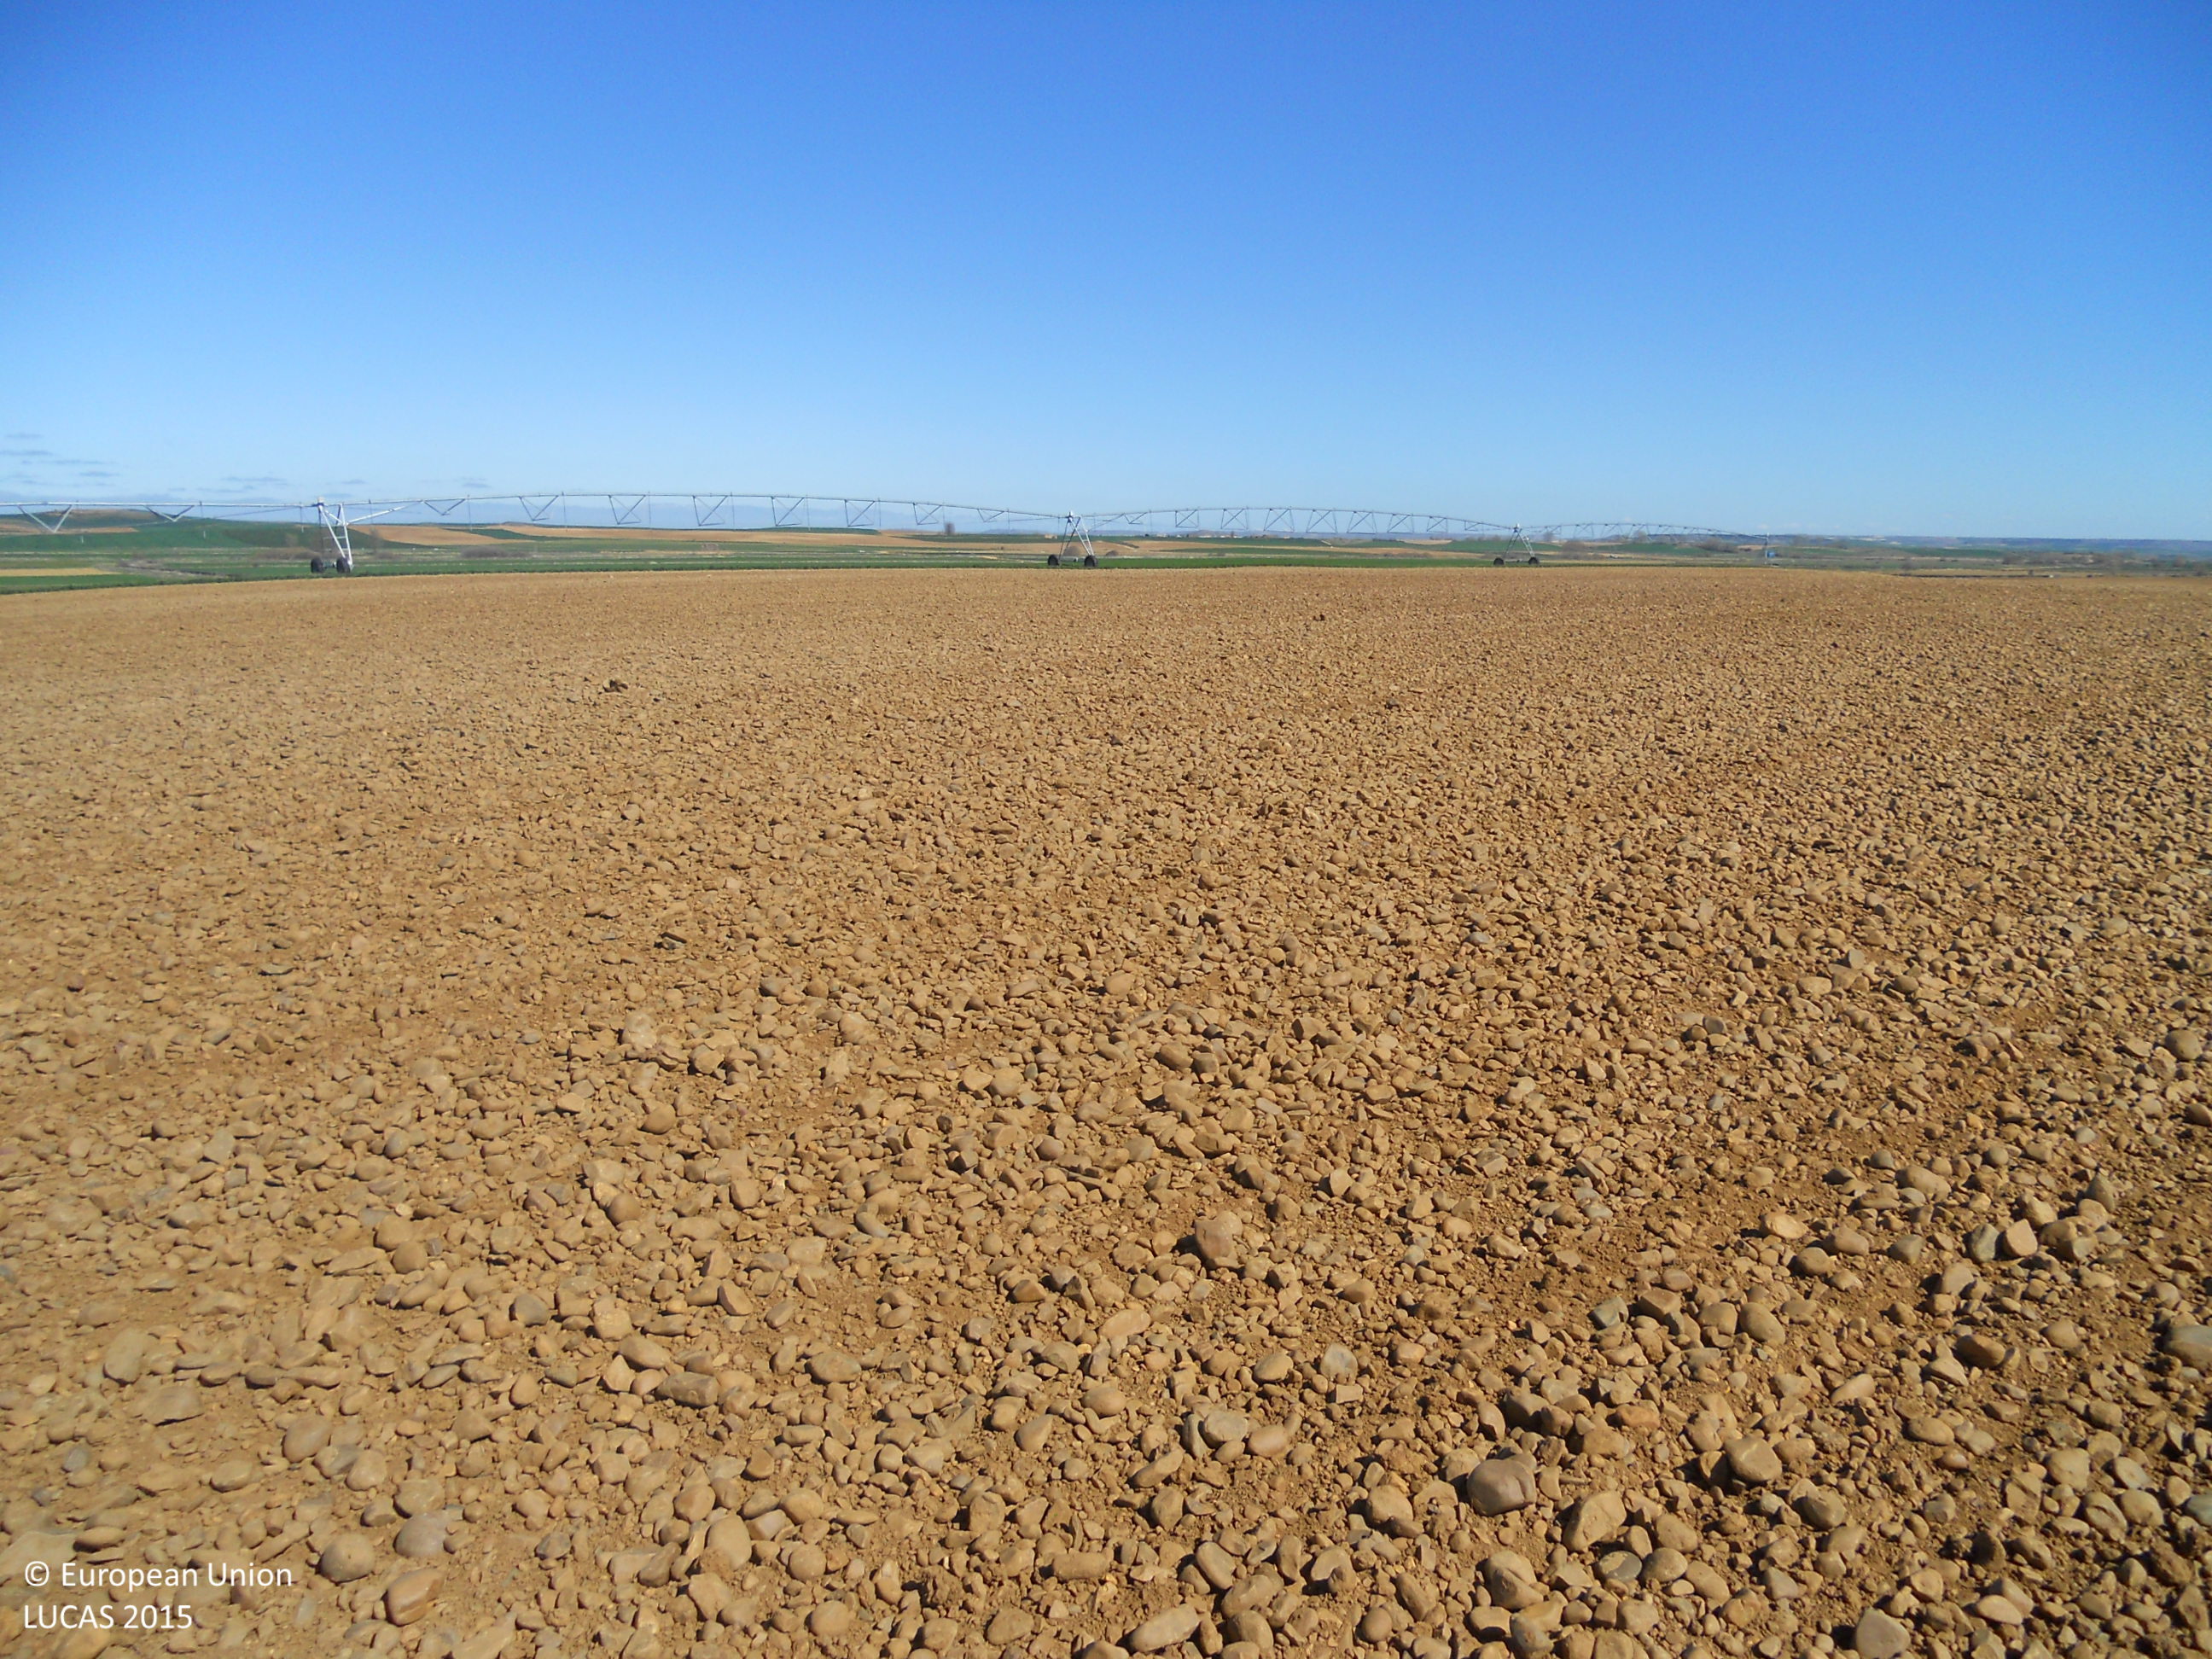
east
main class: Cropland
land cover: Lucerne
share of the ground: > 75 %
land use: Agriculture (excluding fallow land and kitchen gardens)
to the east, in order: Lucerne
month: April
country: ES
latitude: 42.3428
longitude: -4.3330
